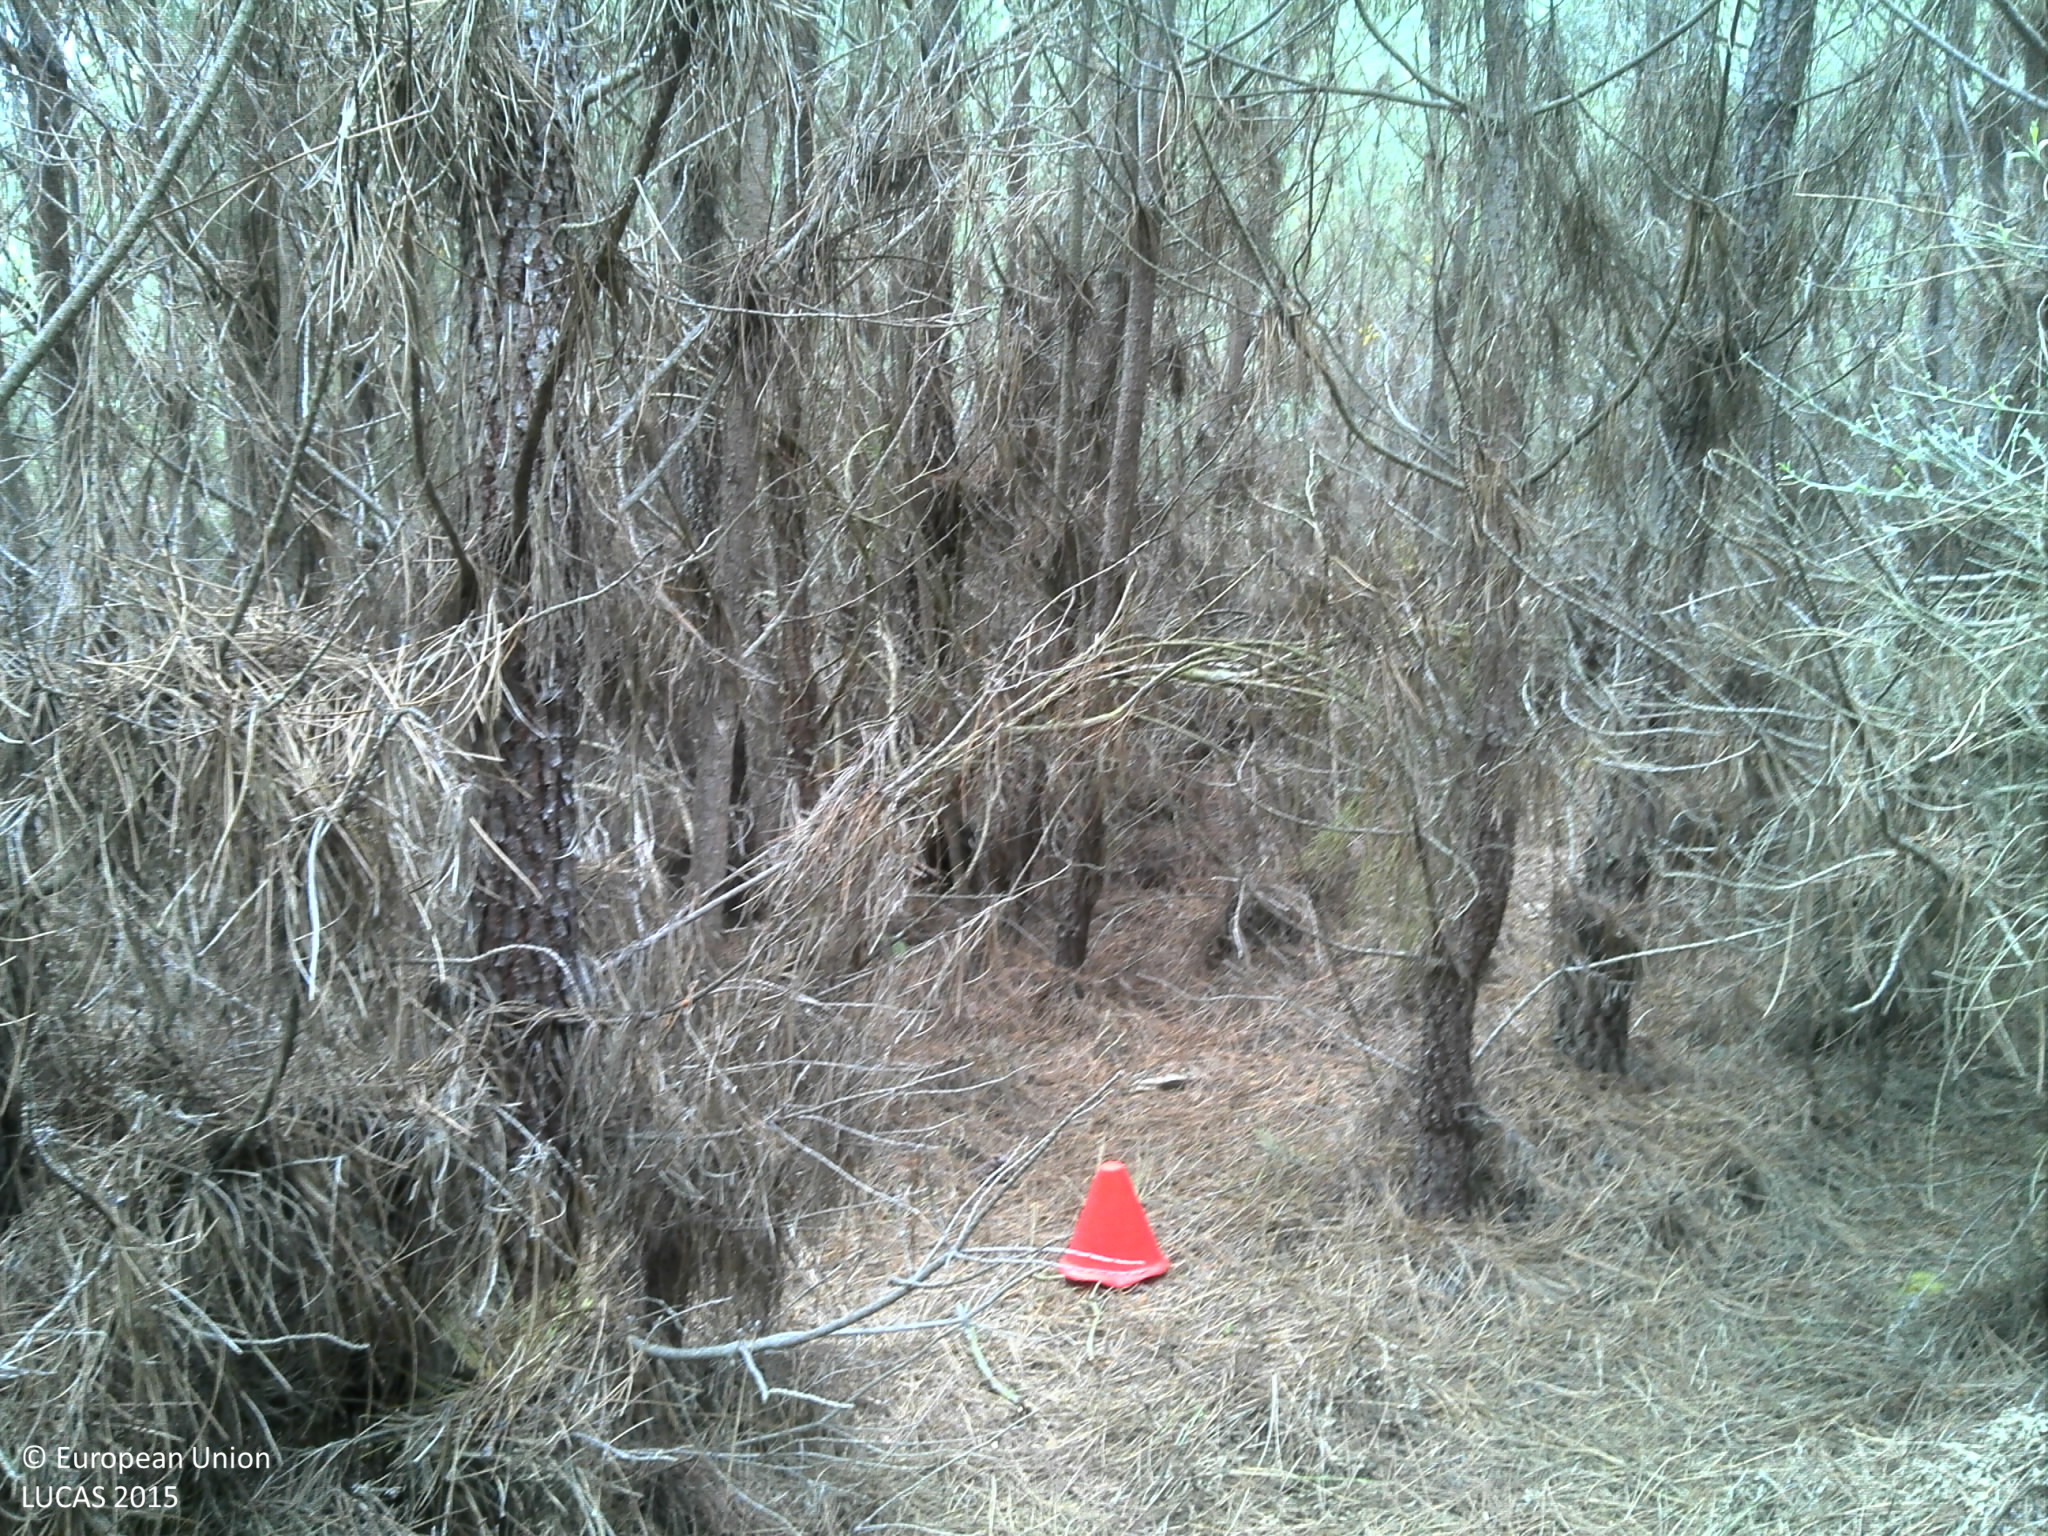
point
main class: Woodland
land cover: Pine dominated coniferous woodland
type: coniferous forest of the mediterranean region
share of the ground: > 75 %
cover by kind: coniferous forest trees 90 %, unconsolidated bare surface 10 %
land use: Forestry
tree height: > 5 m
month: May
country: PT
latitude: 41.6353
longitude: -6.9579
